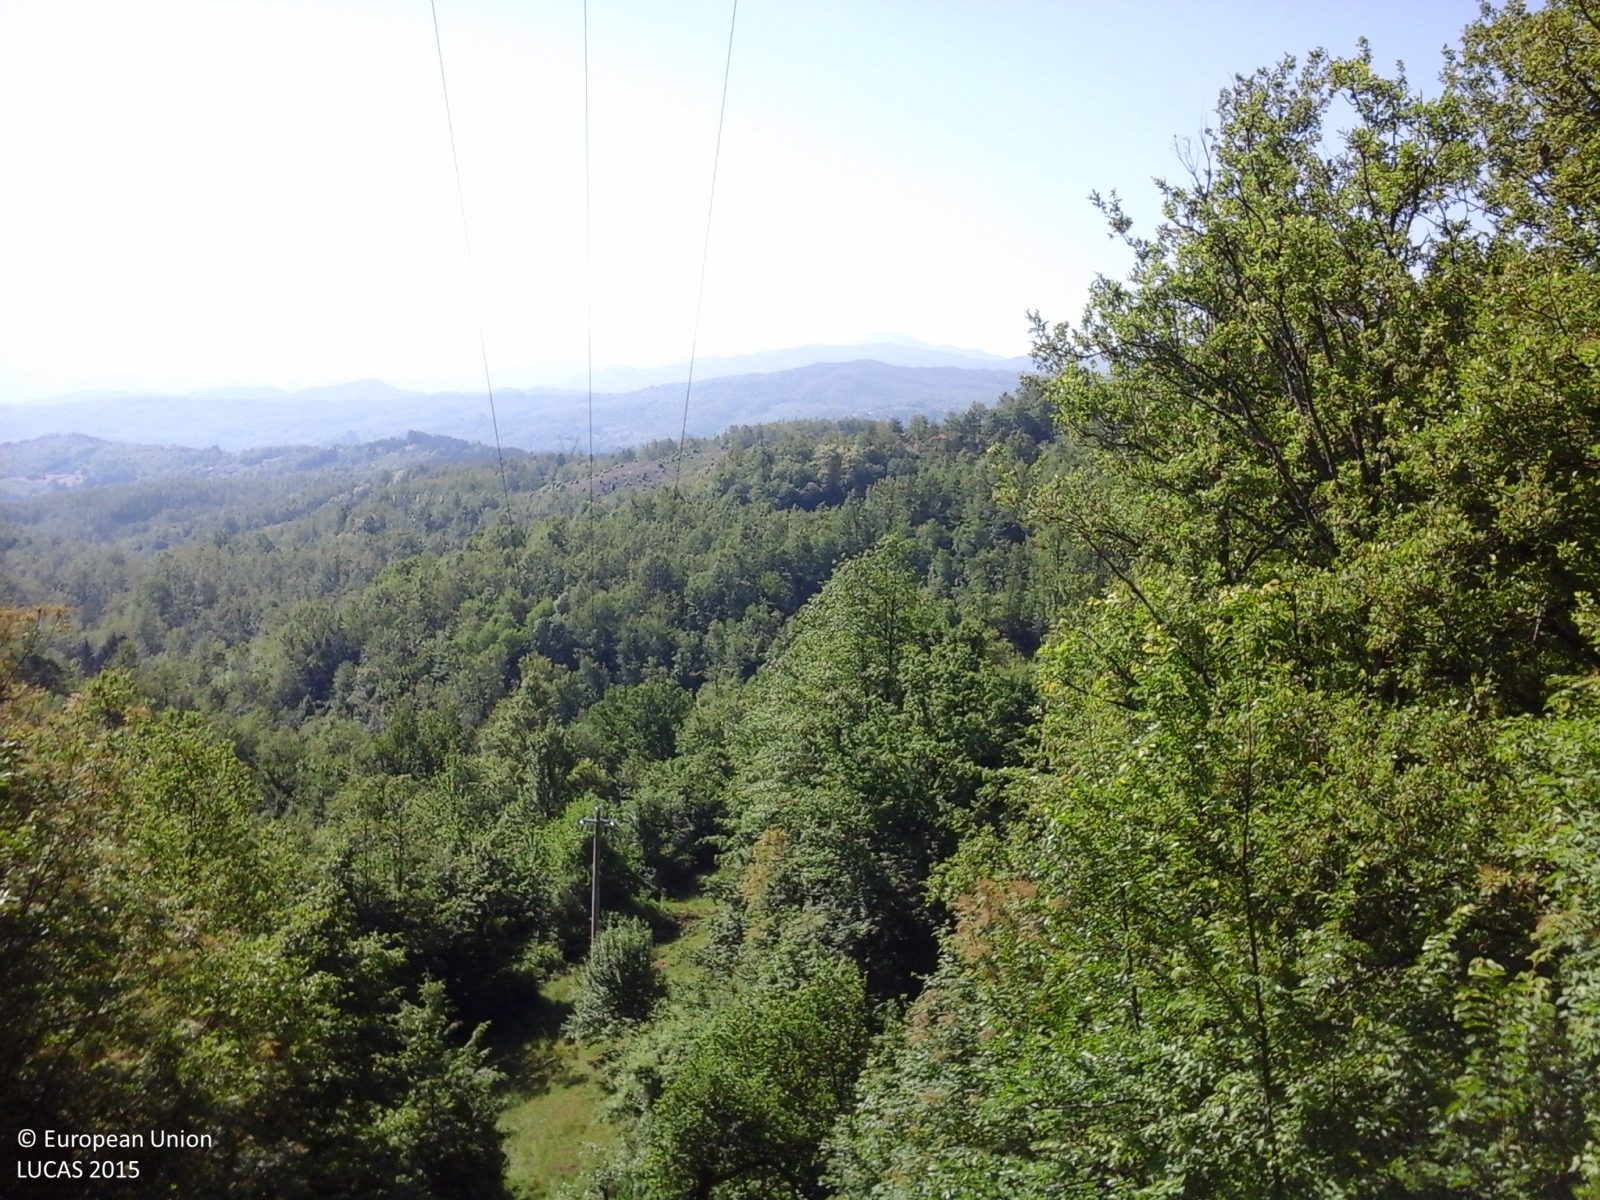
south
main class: Woodland
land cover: Broadleaved woodland
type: thermophilous deciduous forest
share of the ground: > 75 %
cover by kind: broadleaved forest trees 95 %, shrubs 5 %
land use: Forestry
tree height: > 5 m
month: May
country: IT
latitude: 44.5121
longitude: 9.6109
